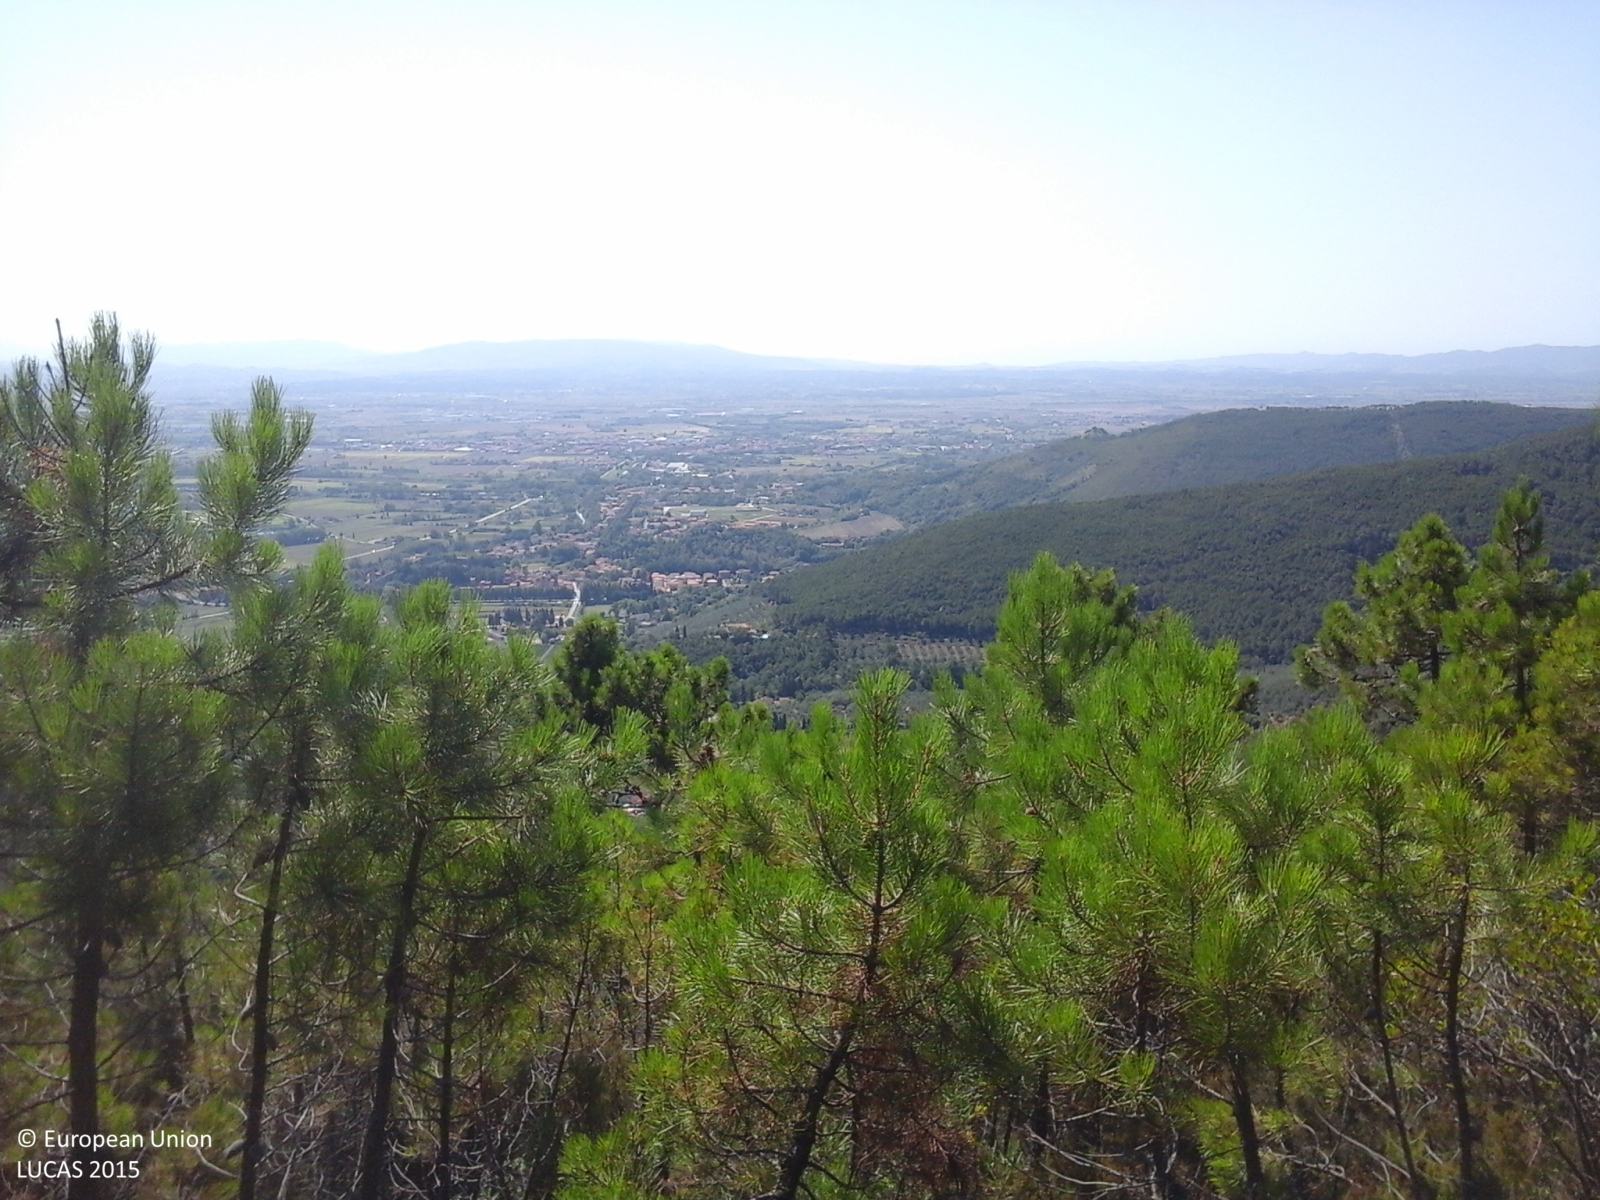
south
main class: Woodland
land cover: Pine dominated coniferous woodland
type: coniferous forest of the mediterranean region
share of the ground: > 75 %
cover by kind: coniferous forest trees 100 %
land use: Forestry
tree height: > 5 m
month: August
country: IT
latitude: 43.7175
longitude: 10.5818
